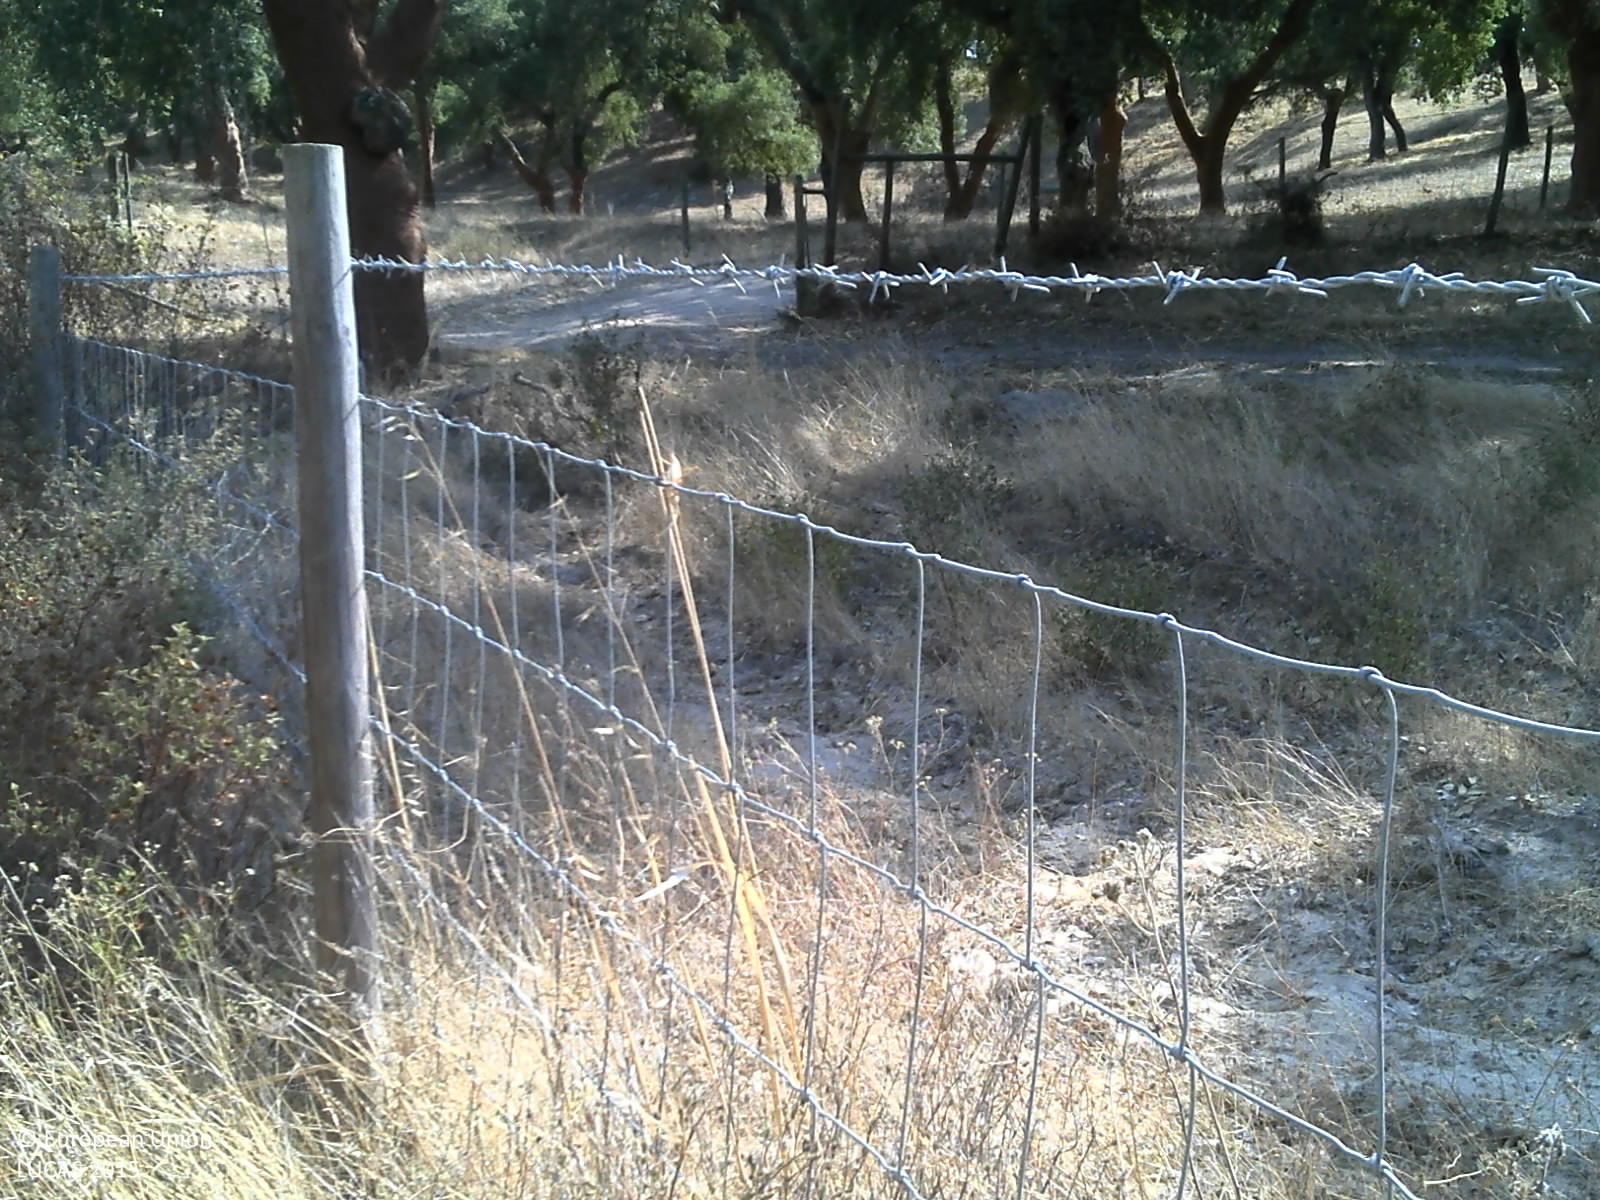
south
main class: Woodland
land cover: Pine dominated coniferous woodland
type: coniferous forest of the mediterranean region
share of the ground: 25 - 50 %
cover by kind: coniferous forest trees 50 %, herbaceous plants 35 %, unconsolidated bare surface 15 %
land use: Forestry
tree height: < 5 m
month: August
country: PT
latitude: 38.7448
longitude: -8.5248
